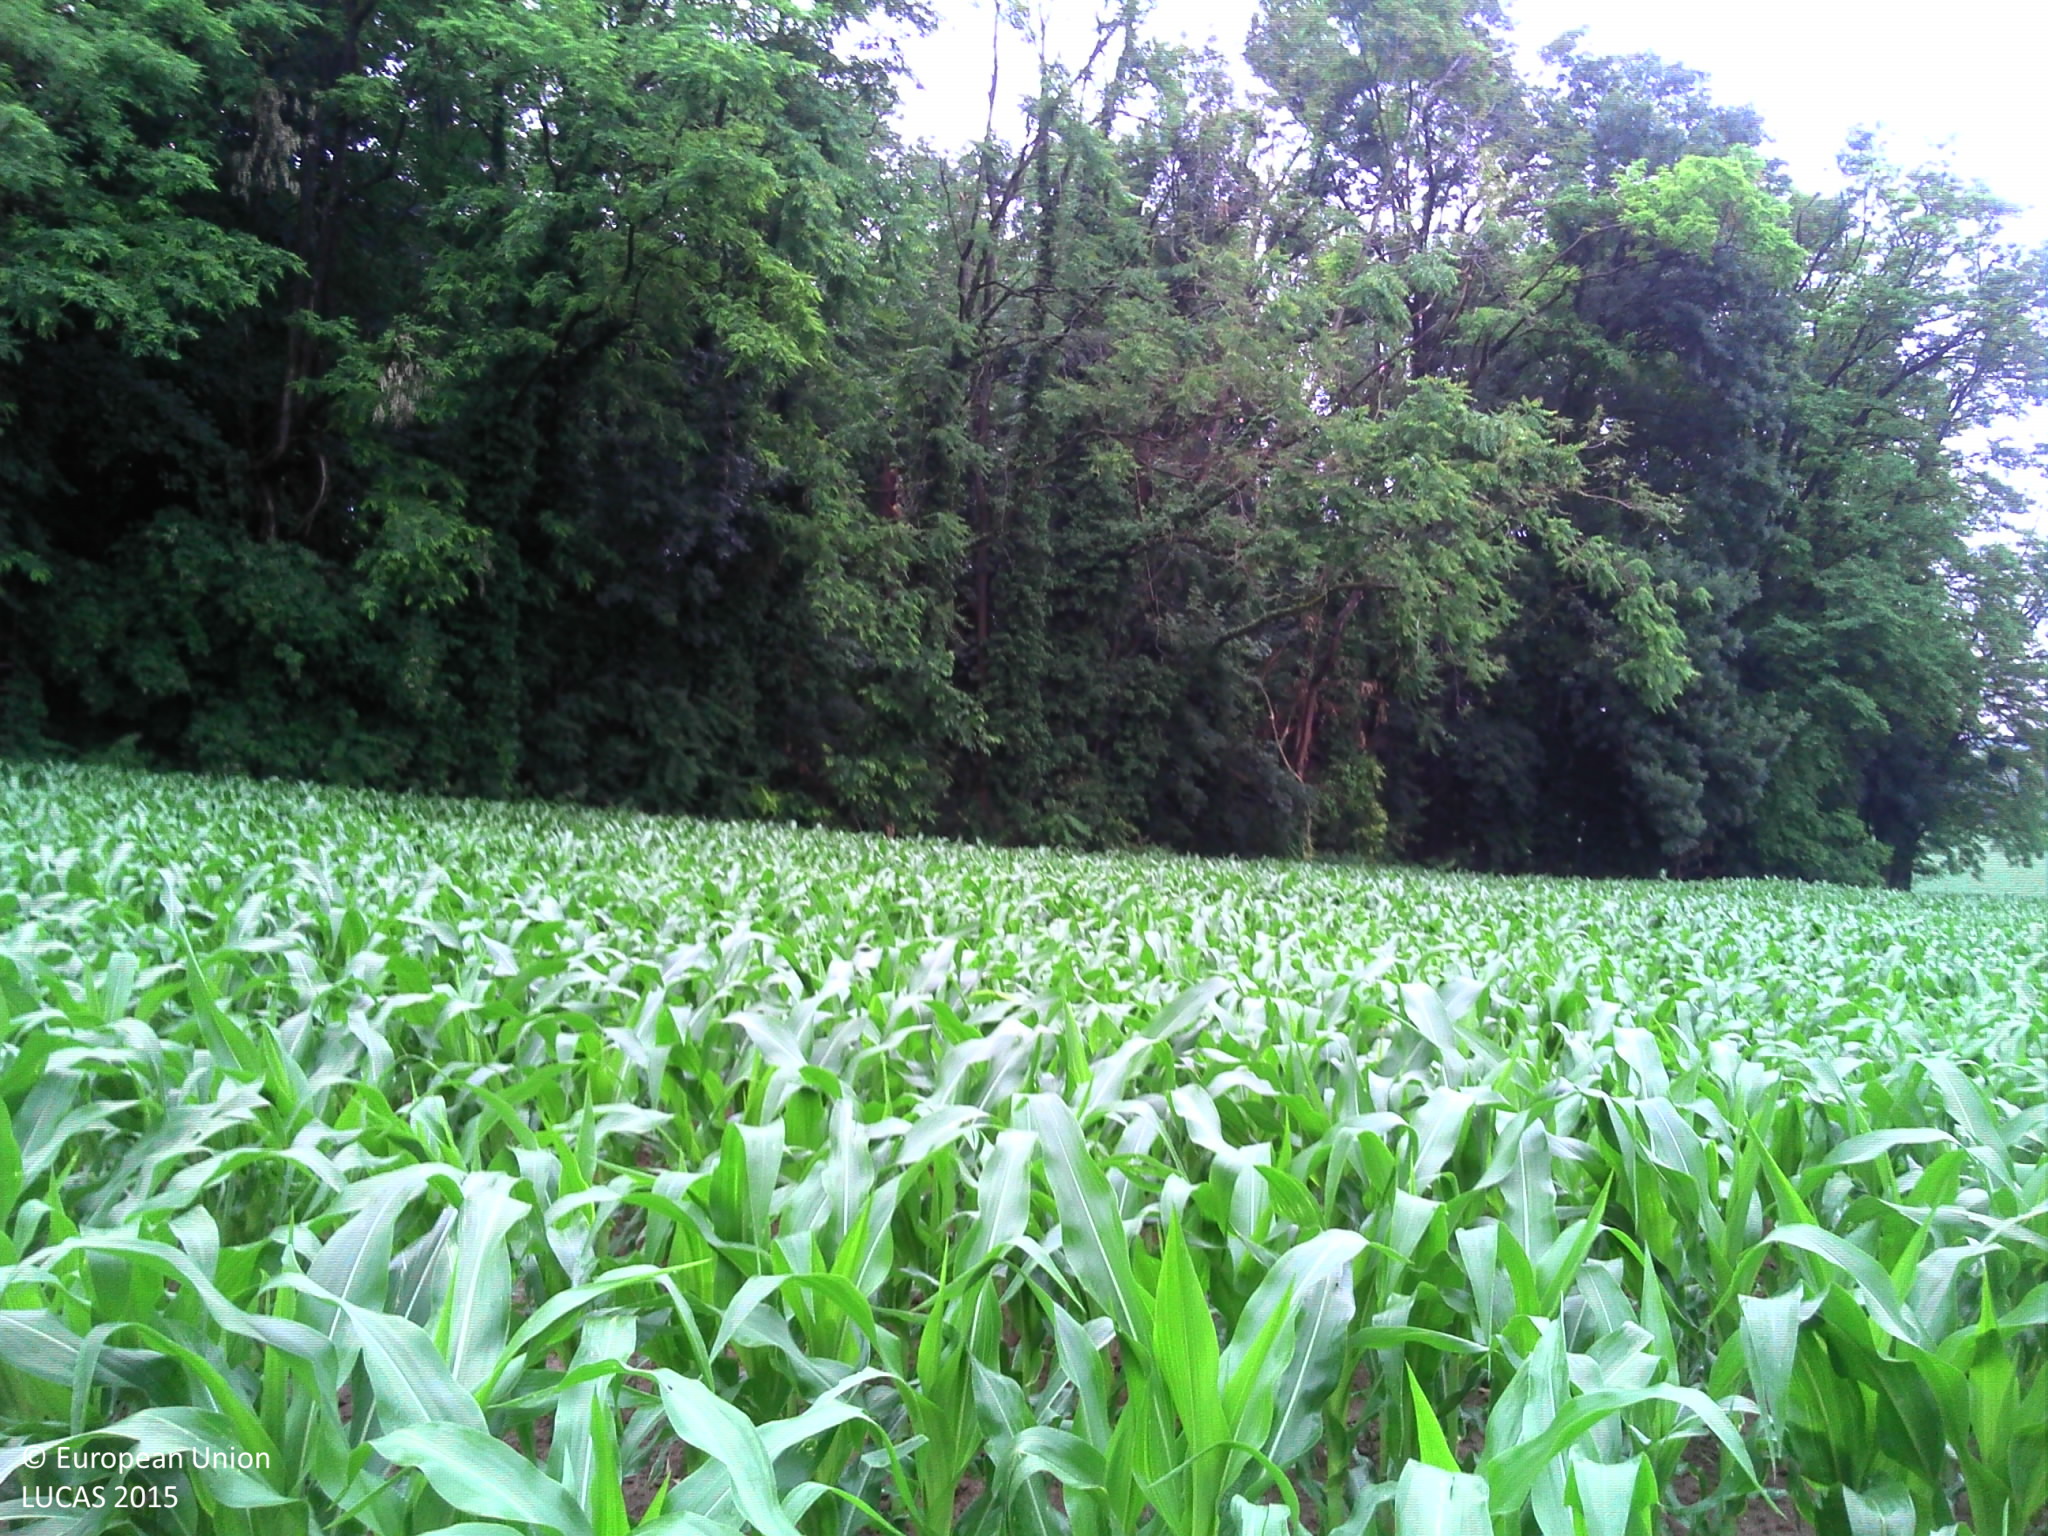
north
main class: Cropland
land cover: Maize
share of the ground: > 75 %
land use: Agriculture (excluding fallow land and kitchen gardens)
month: June
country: FR
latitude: 47.7062
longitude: 7.3760
